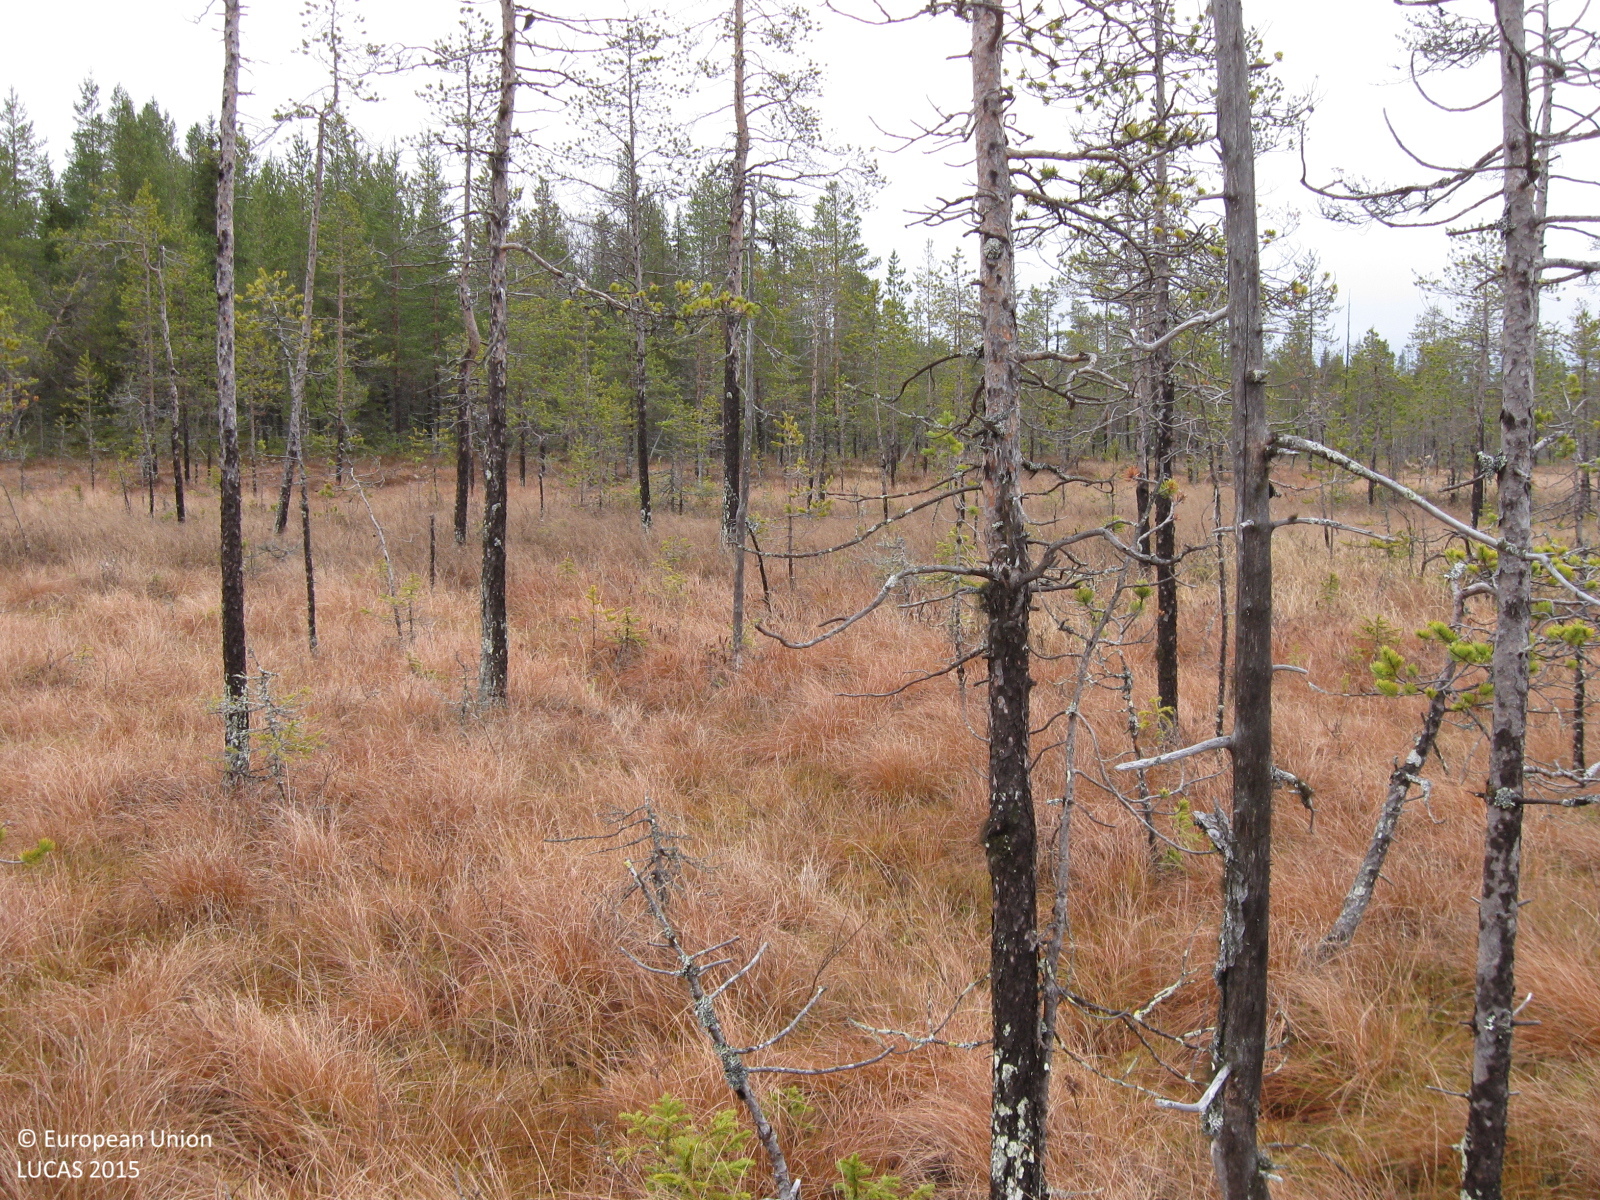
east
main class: Woodland
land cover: Pine dominated coniferous woodland
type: mire and swamp forests
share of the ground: 25 - 50 %
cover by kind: herbaceous plants 60 %, coniferous forest trees 25 %, lichens and mosses 10 %, shrubs 5 %
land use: Semi-natural and natural areas not in use
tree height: < 5 m
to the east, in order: Pine dominated coniferous woodland; Peatbogs; Pine dominated coniferous woodland; Spruce dominated mixed woodland; Broadleaved woodland; Inland fresh running water; Broadleaved woodland; Pine dominated coniferous woodland; Pine dominated mixed woodland
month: October
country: SE
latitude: 66.6479
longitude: 21.8326
